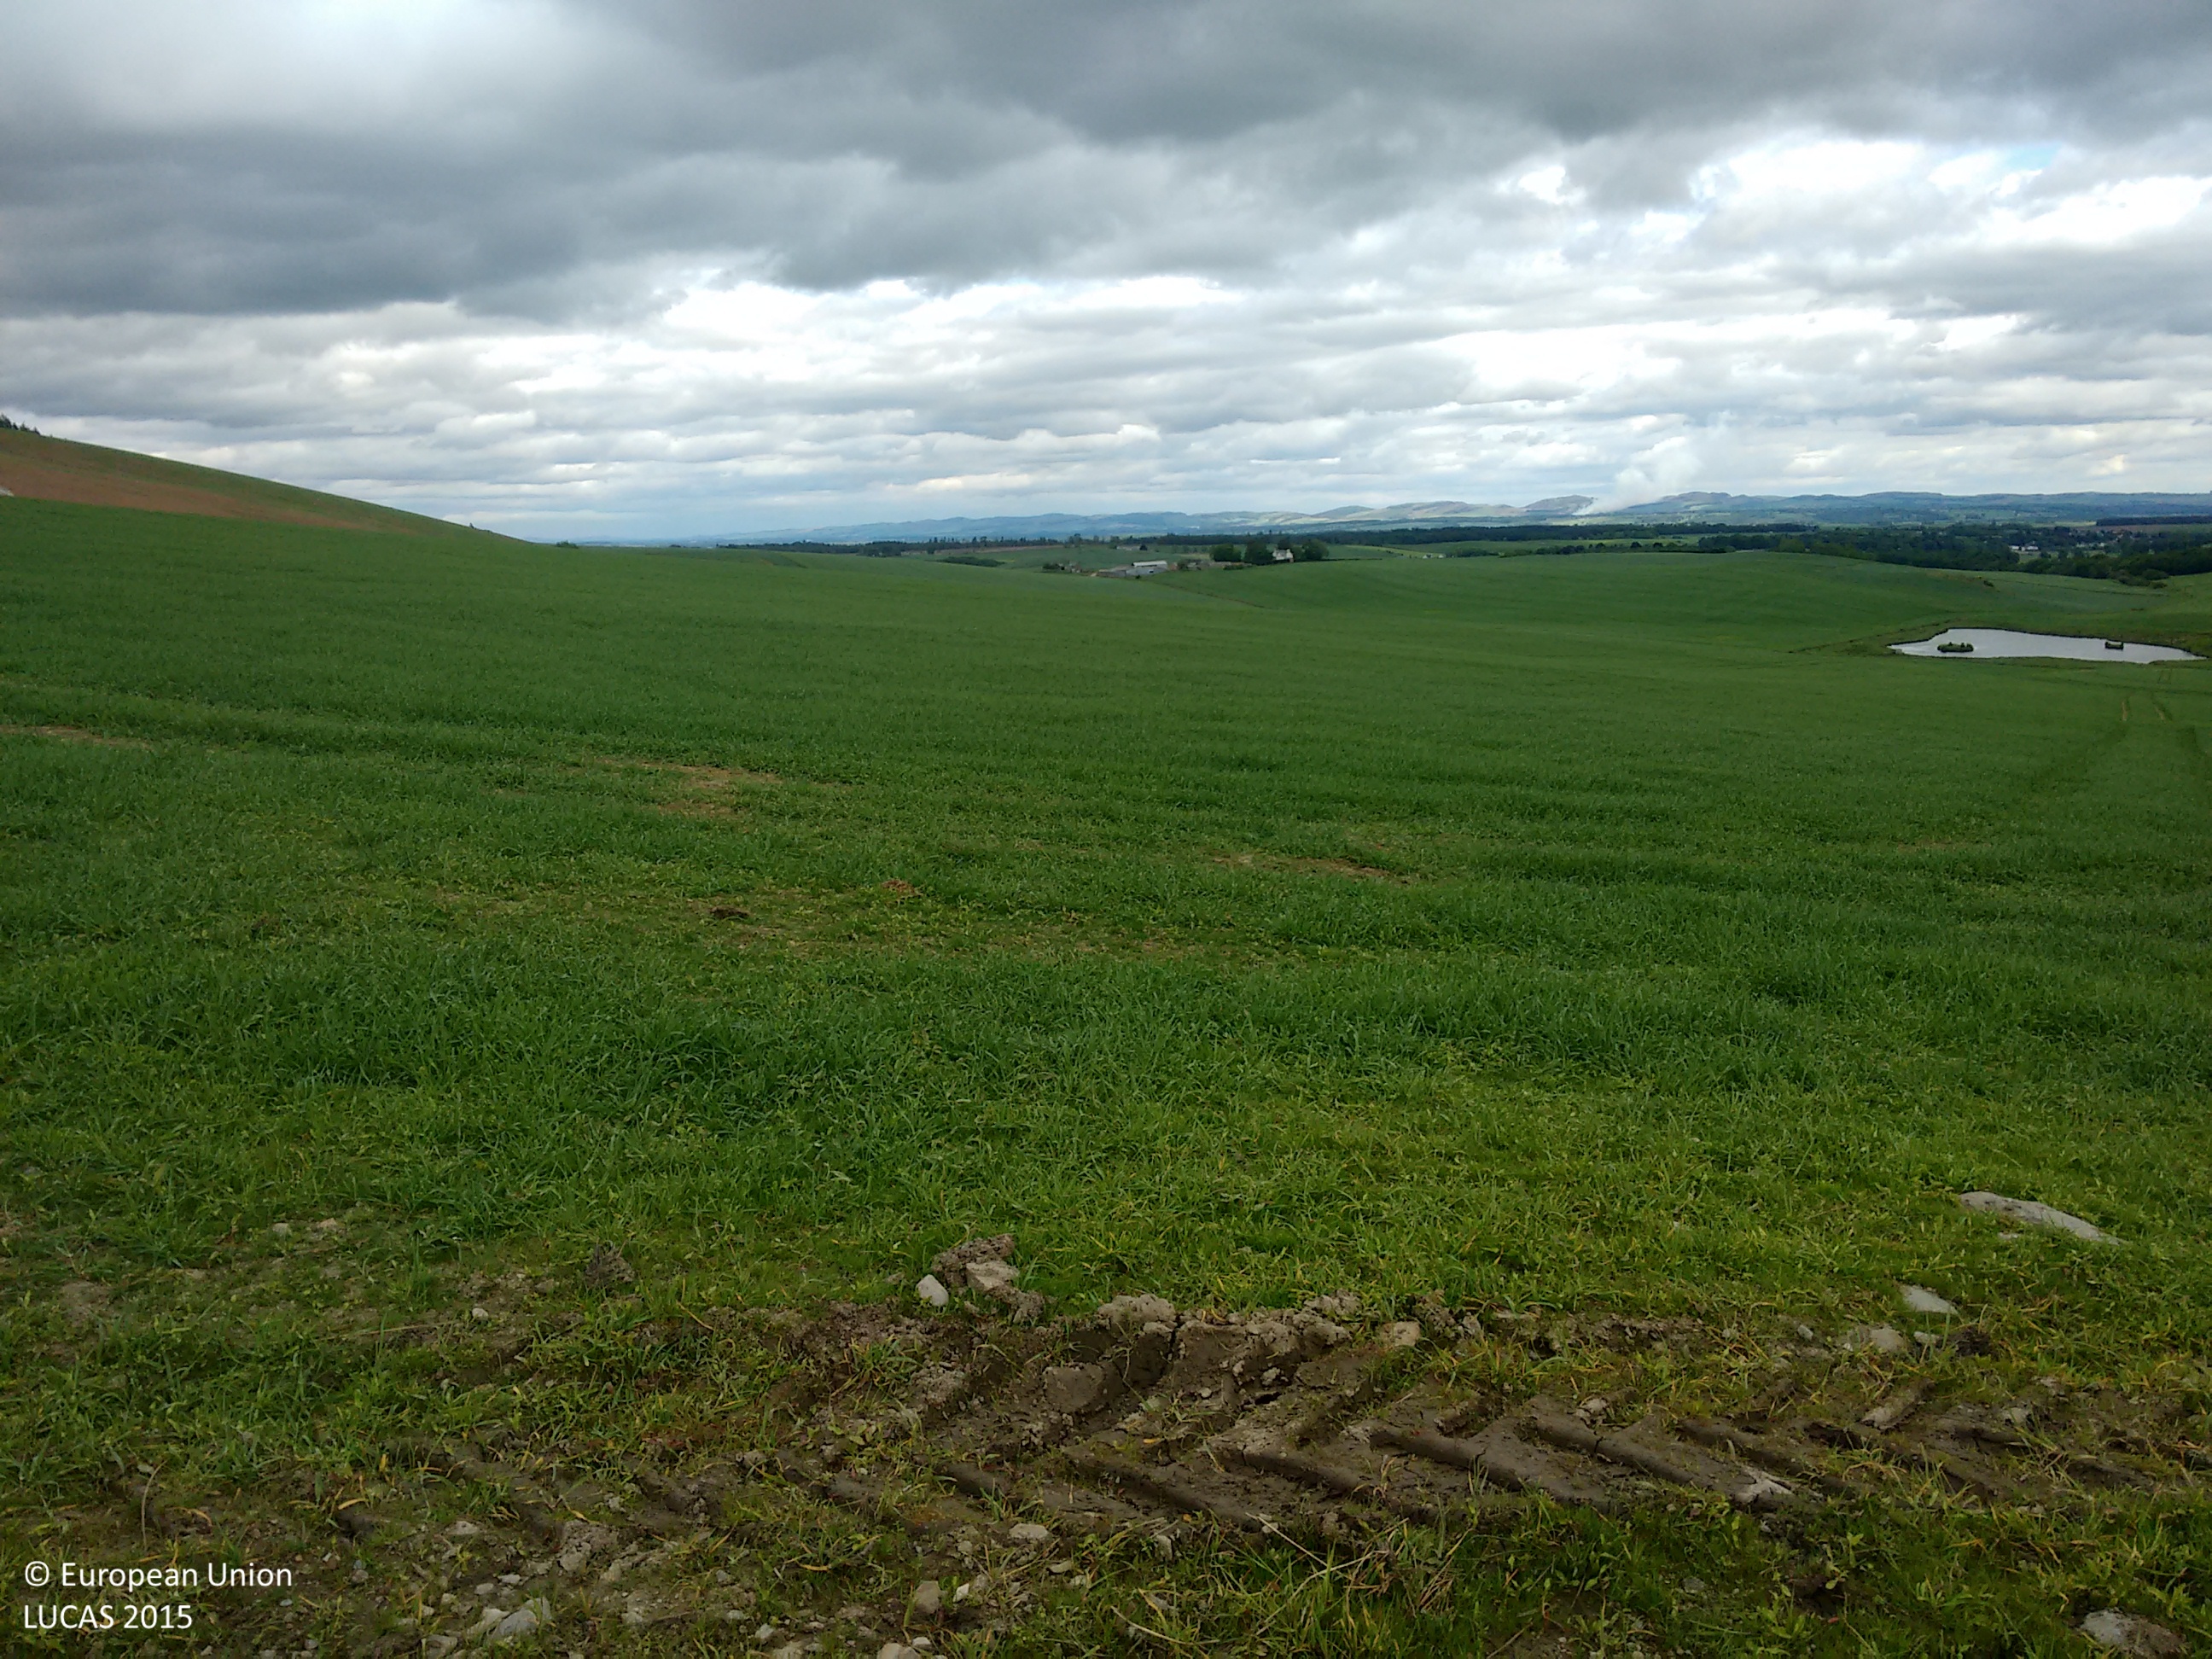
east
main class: Grassland
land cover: Grassland without tree/shrub cover
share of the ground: > 75 %
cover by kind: unconsolidated bare surface 70 %, herbaceous plants 30 %
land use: Agriculture (excluding fallow land and kitchen gardens)
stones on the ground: 25 - 50 %
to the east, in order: Grassland without tree/shrub cover; Barley
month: June
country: GB
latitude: 56.5203
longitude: -3.5837
